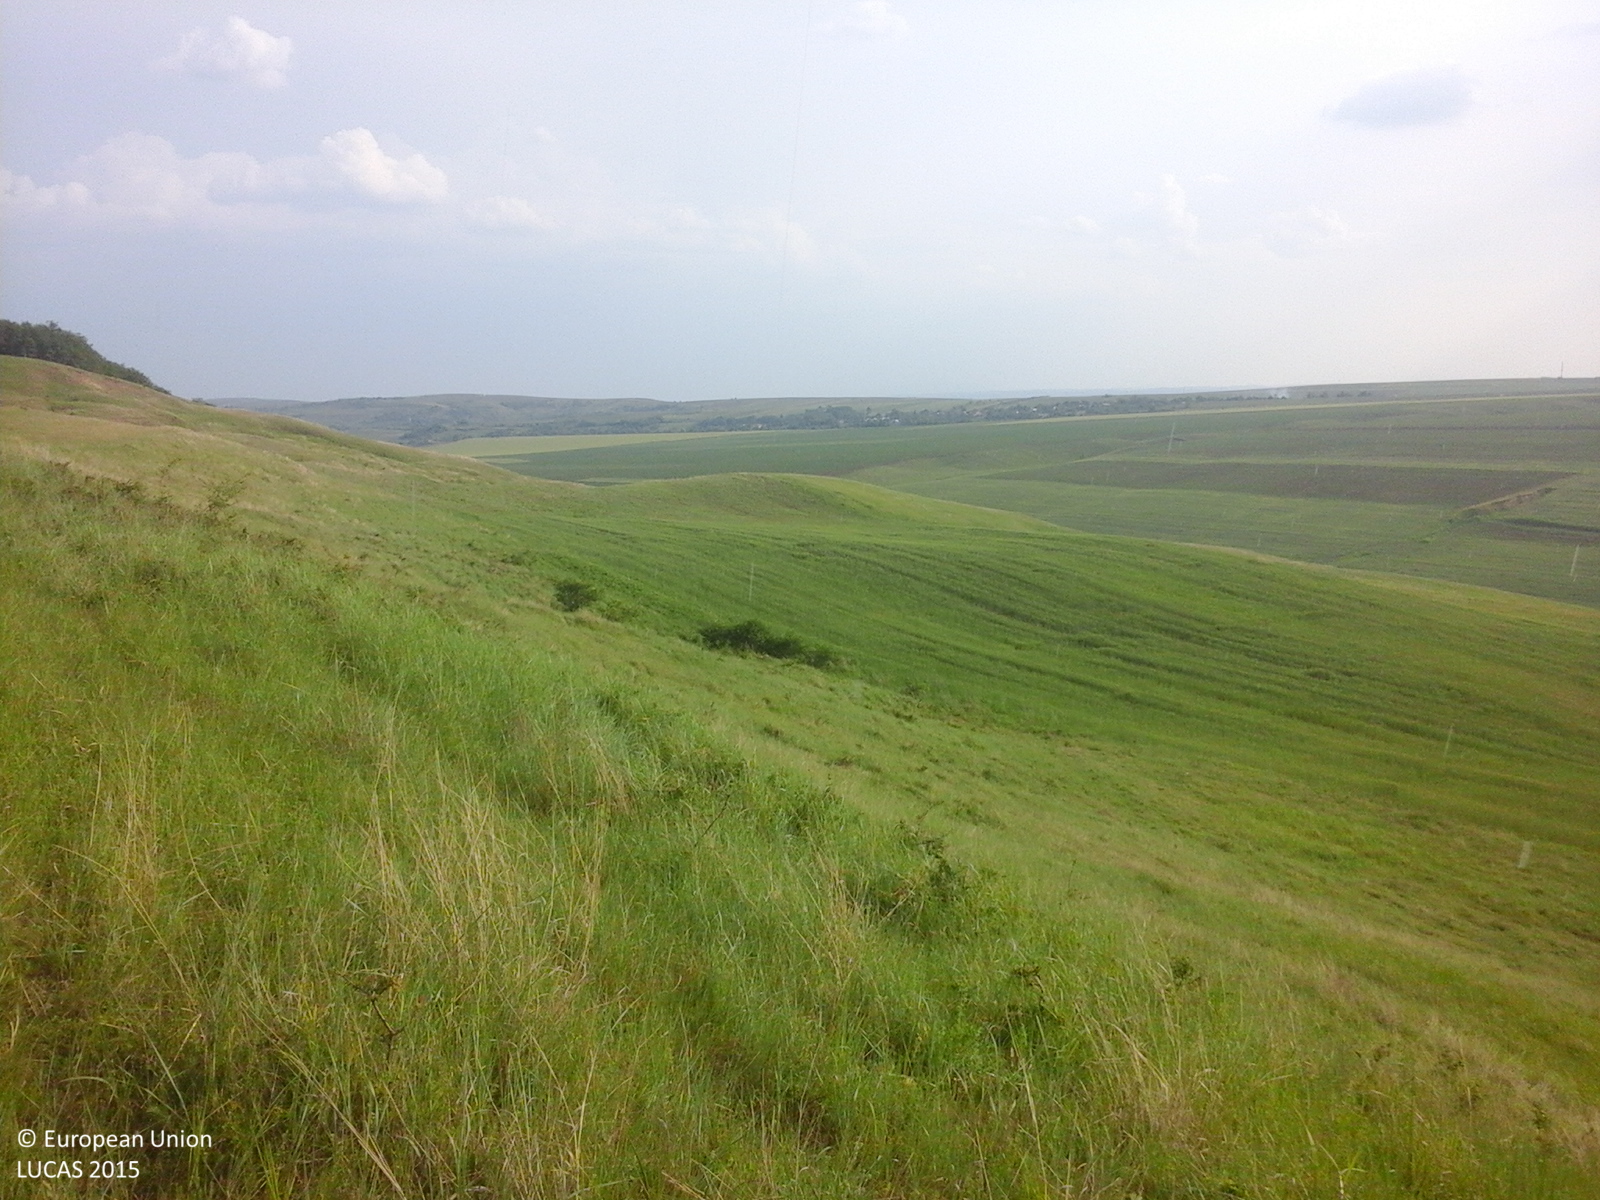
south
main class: Grassland
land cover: Grassland without tree/shrub cover
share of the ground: > 75 %
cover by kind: herbaceous plants 100 %
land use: Agriculture (excluding fallow land and kitchen gardens)
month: June
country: RO
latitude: 46.2885
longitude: 27.1946
